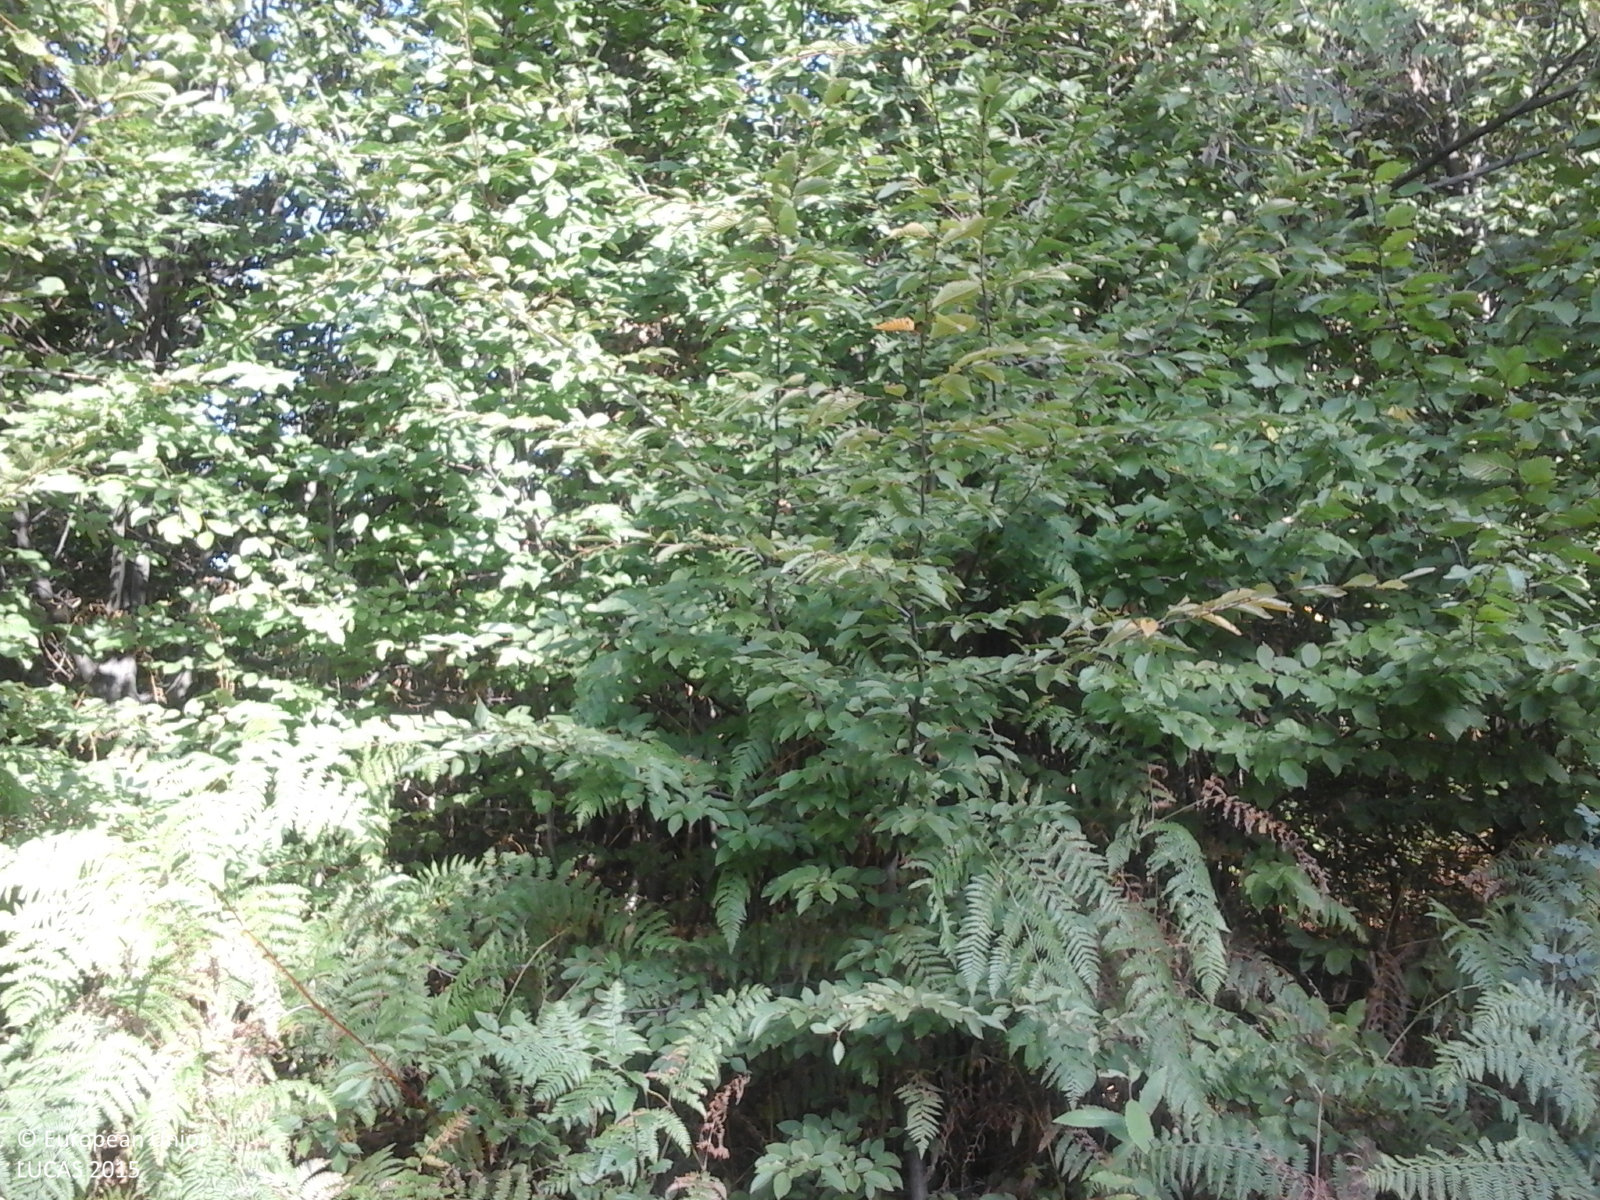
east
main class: Shrubland
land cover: Shrubland with sparse tree cover
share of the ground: > 75 %
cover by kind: shrubs 95 %, broadleaved forest trees 5 %
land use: Semi-natural and natural areas not in use
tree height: < 5 m
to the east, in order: Shrubland with sparse tree cover; Spontaneously vegetated surfaces; Tracks; Broadleaved woodland; Tracks; Broadleaved woodland; Shrubland with sparse tree cover; Spontaneously vegetated surfaces
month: September
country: RO
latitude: 45.0866
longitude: 22.9447
